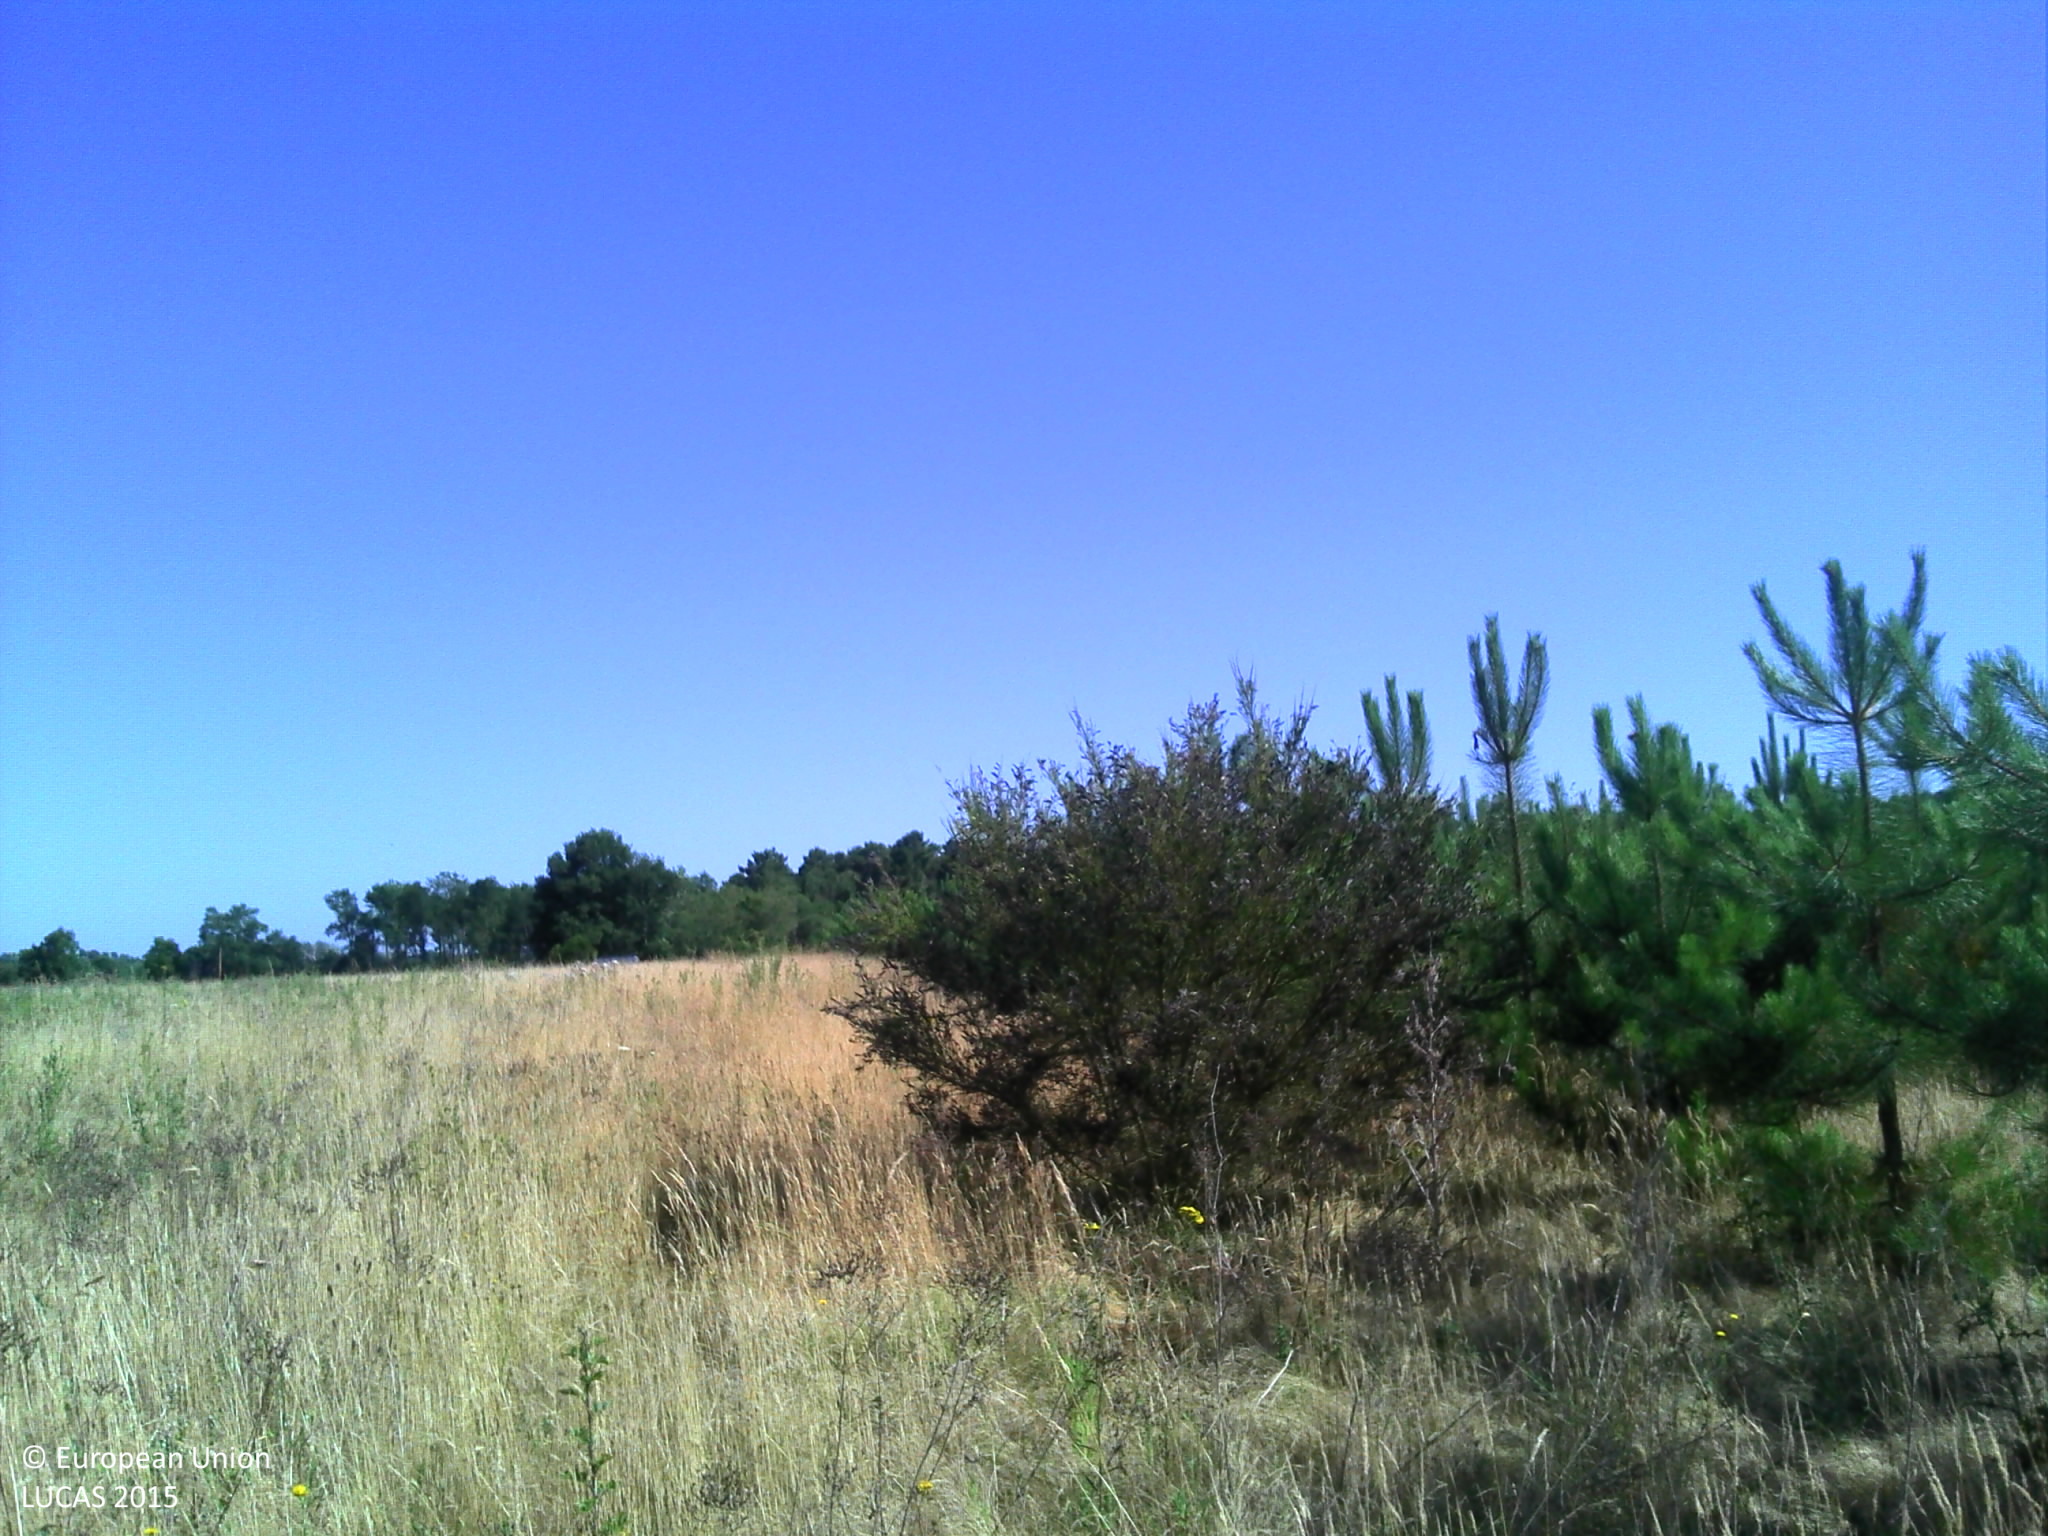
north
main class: Grassland
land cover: Grassland without tree/shrub cover
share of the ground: > 75 %
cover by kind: herbaceous plants 100 %
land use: Agriculture (excluding fallow land and kitchen gardens)
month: July
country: FR
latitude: 47.6473
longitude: 0.2712
